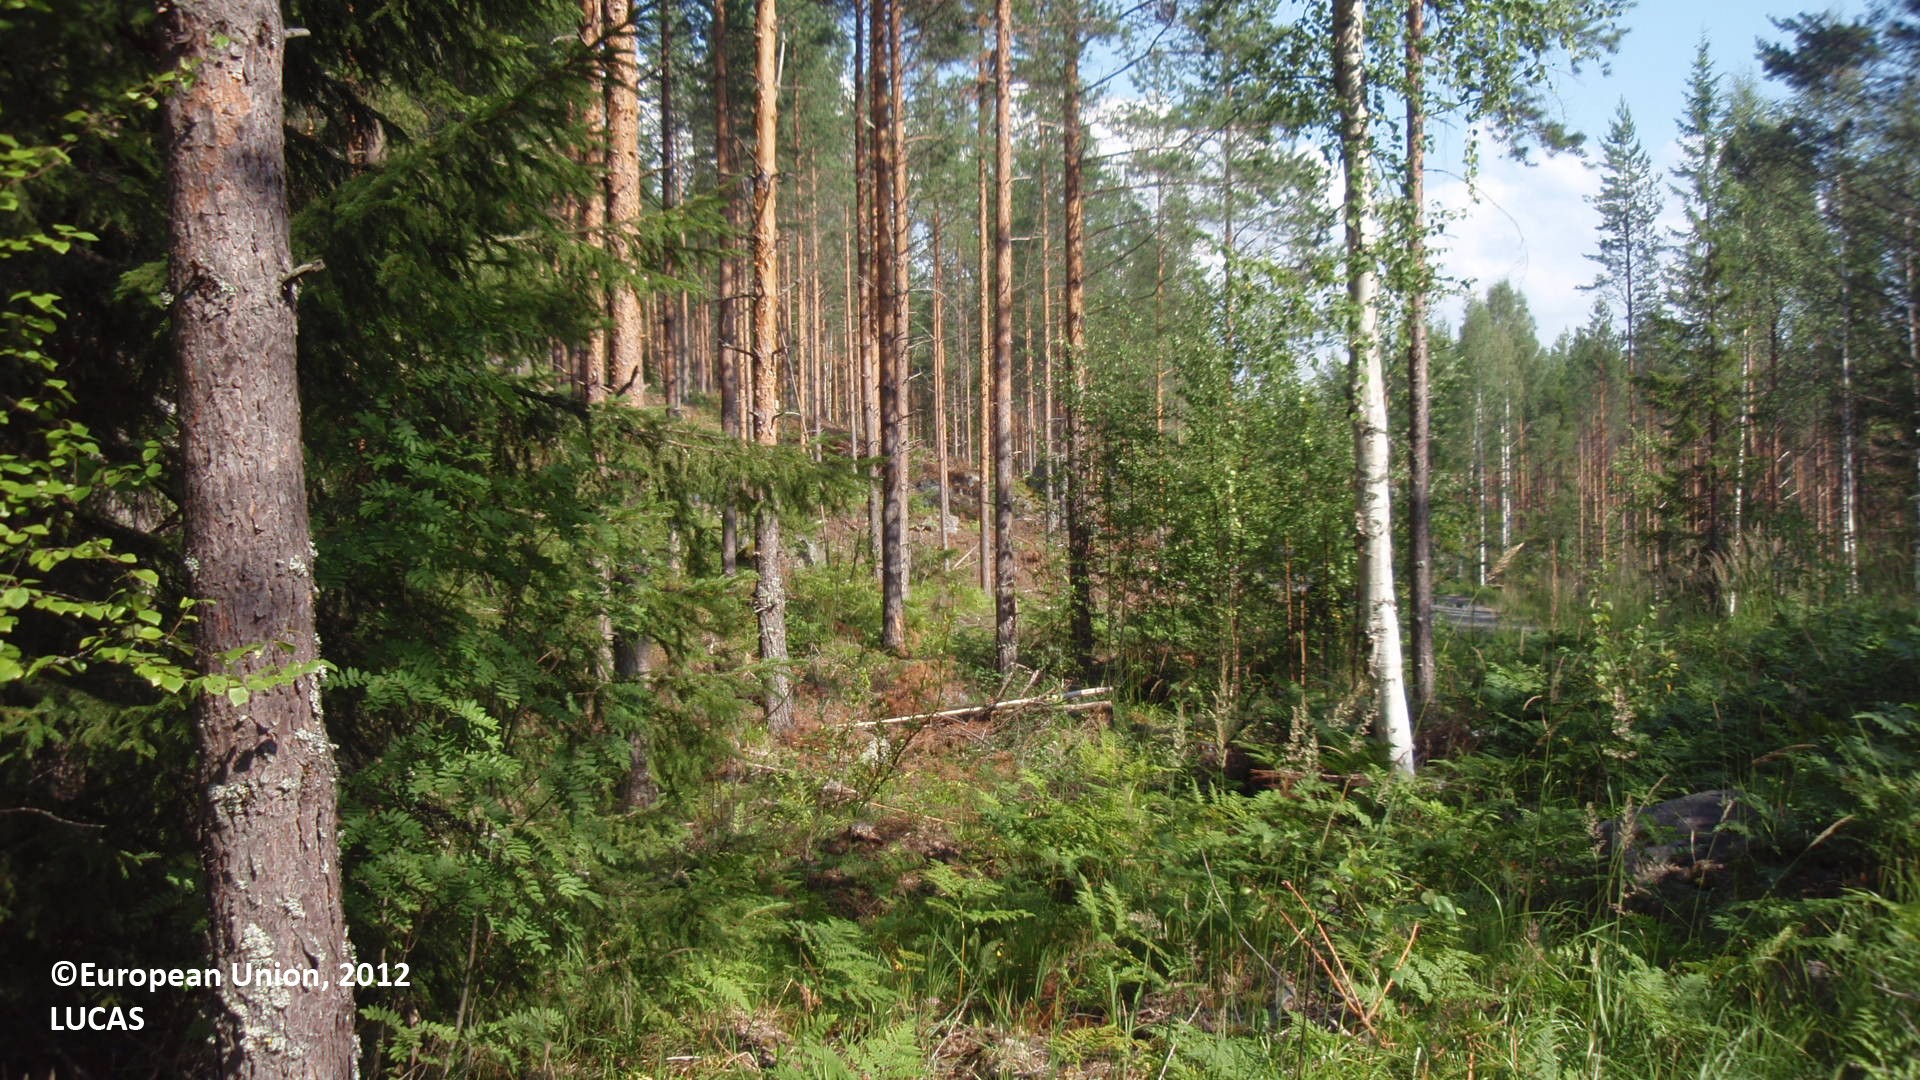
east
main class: Woodland
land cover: Pine dominated coniferous woodland
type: boreal forest
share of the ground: 50 - 75 %
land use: Forestry
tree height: > 5 m
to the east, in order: Pine dominated coniferous woodland
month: July
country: FI
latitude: 61.3889
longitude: 28.3861
